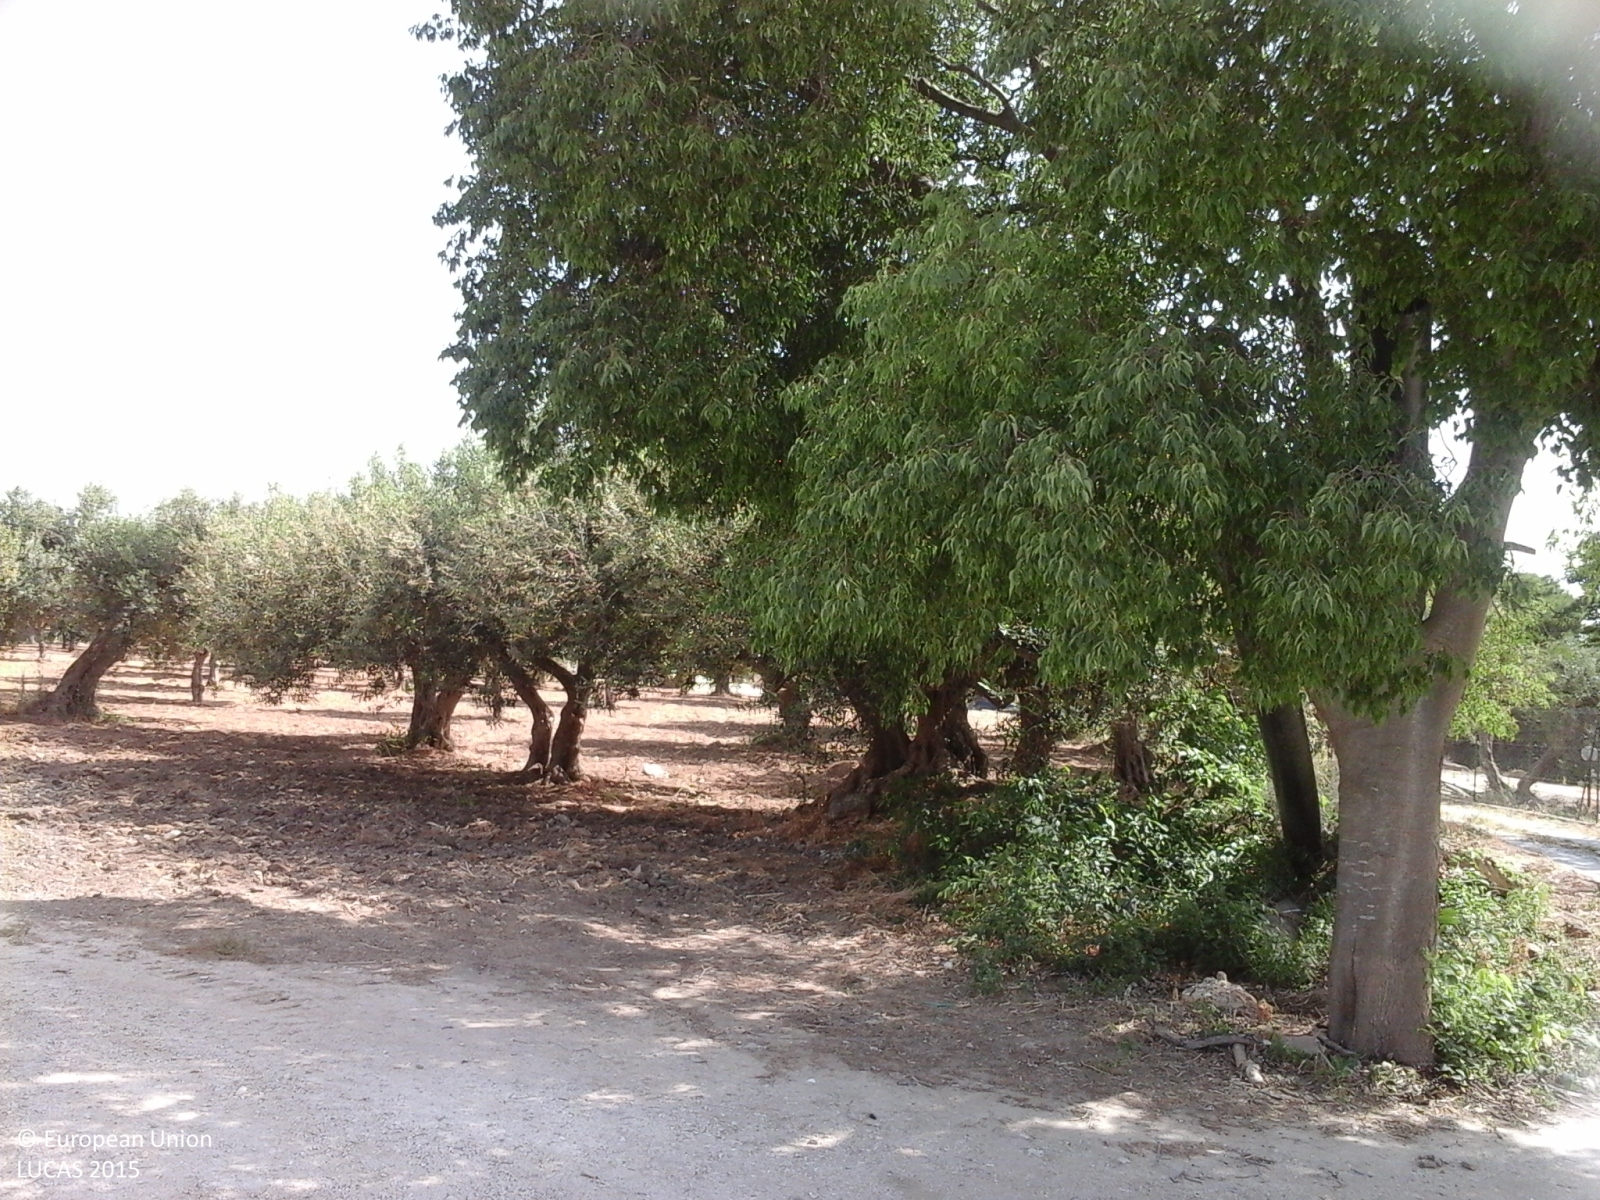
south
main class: Cropland
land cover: Olive groves
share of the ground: 25 - 50 %
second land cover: Other bare soil
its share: > 75 %
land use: Agriculture (excluding fallow land and kitchen gardens)
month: May
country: IT
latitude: 37.5346
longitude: 13.0660
